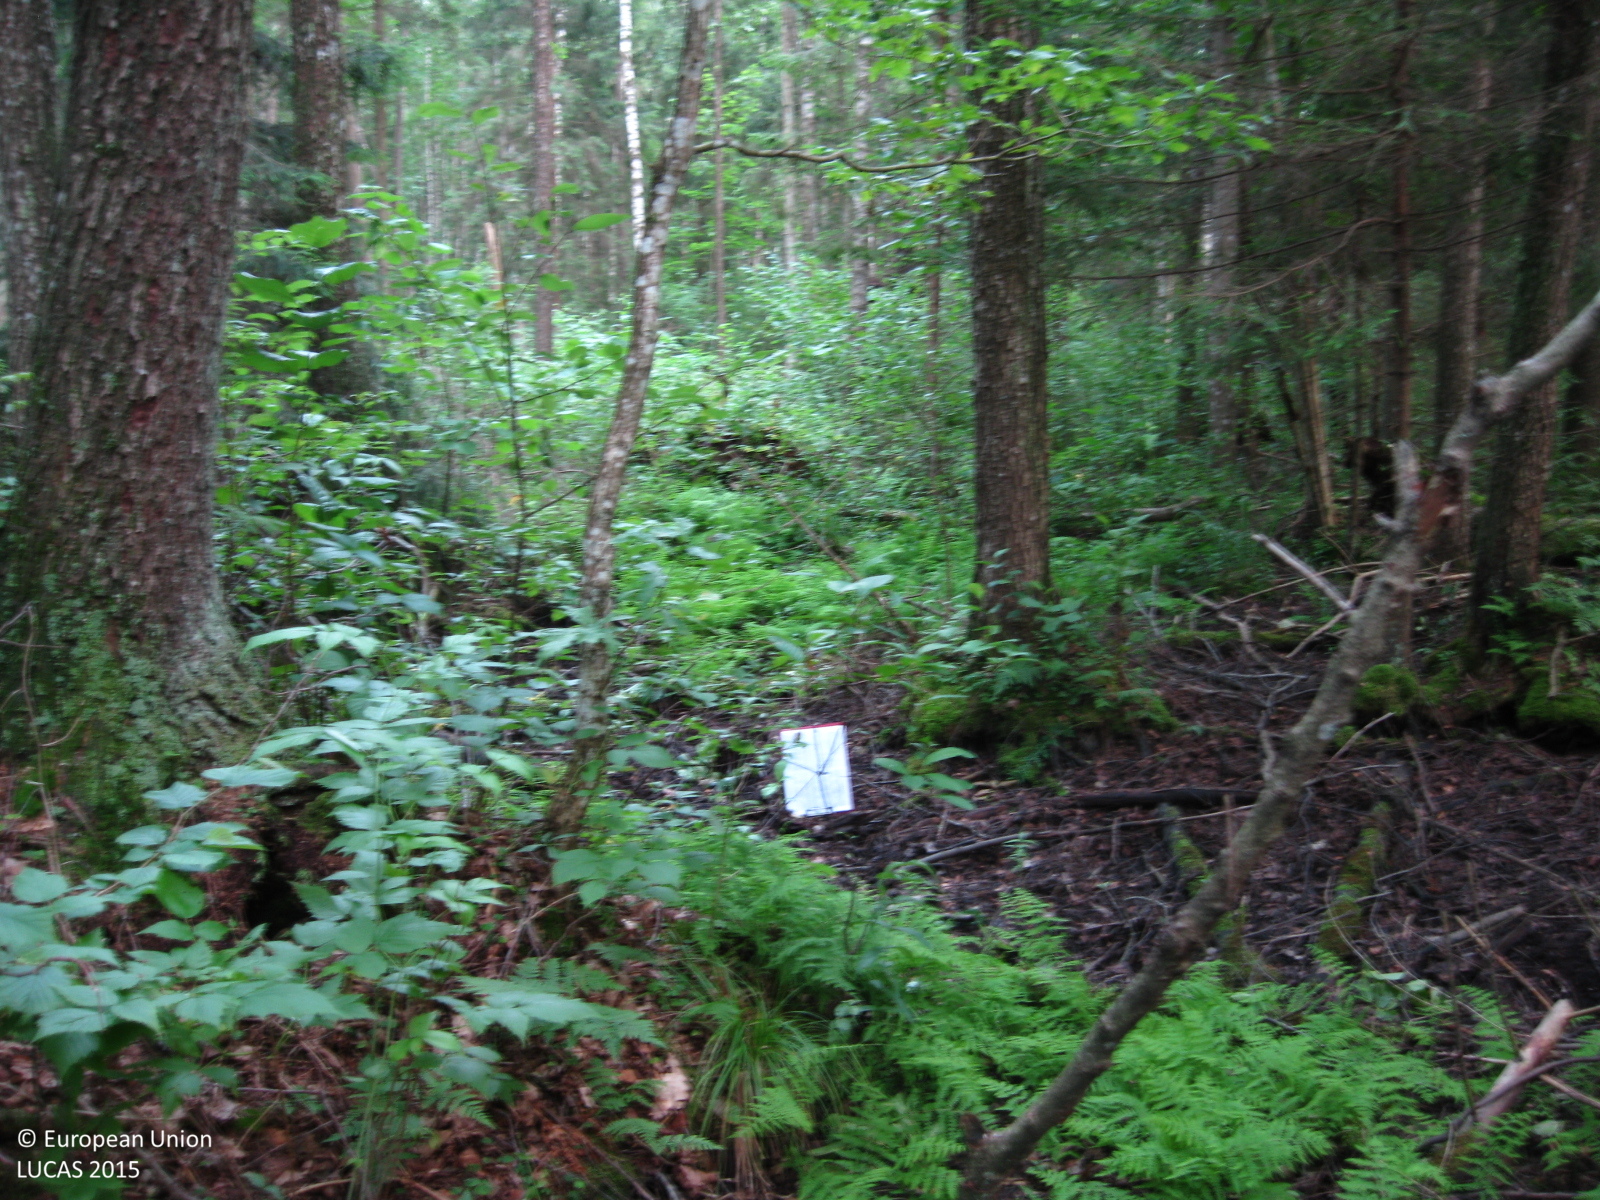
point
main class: Woodland
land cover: Spruce dominated mixed woodland
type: hemiboreal forest and nemoral coniferous forest and mixed broadleaved-coniferous forest
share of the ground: > 75 %
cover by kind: coniferous forest trees 45 %, broadleaved forest trees 35 %, herbaceous plants 10 %, shrubs 5 %, unconsolidated bare surface 5 %
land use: Forestry
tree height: > 5 m
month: July
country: LT
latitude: 55.3995
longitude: 24.6145
